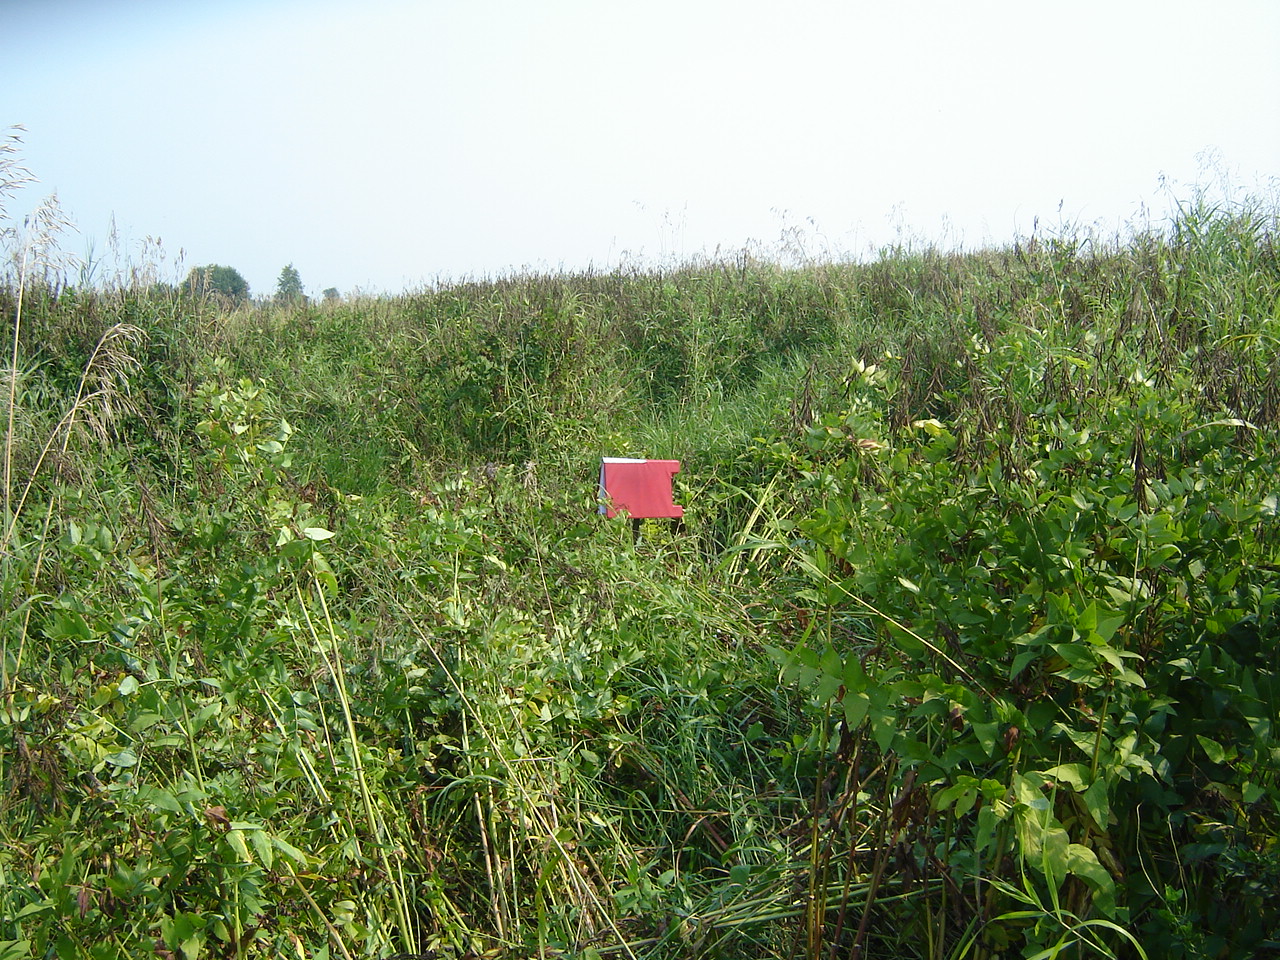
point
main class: Grassland
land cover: Spontaneously vegetated surfaces
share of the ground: > 75 %
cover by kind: herbaceous plants 100 %
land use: Fallow land
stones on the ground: < 10 %
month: August
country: LT
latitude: 54.8738
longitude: 25.0285
